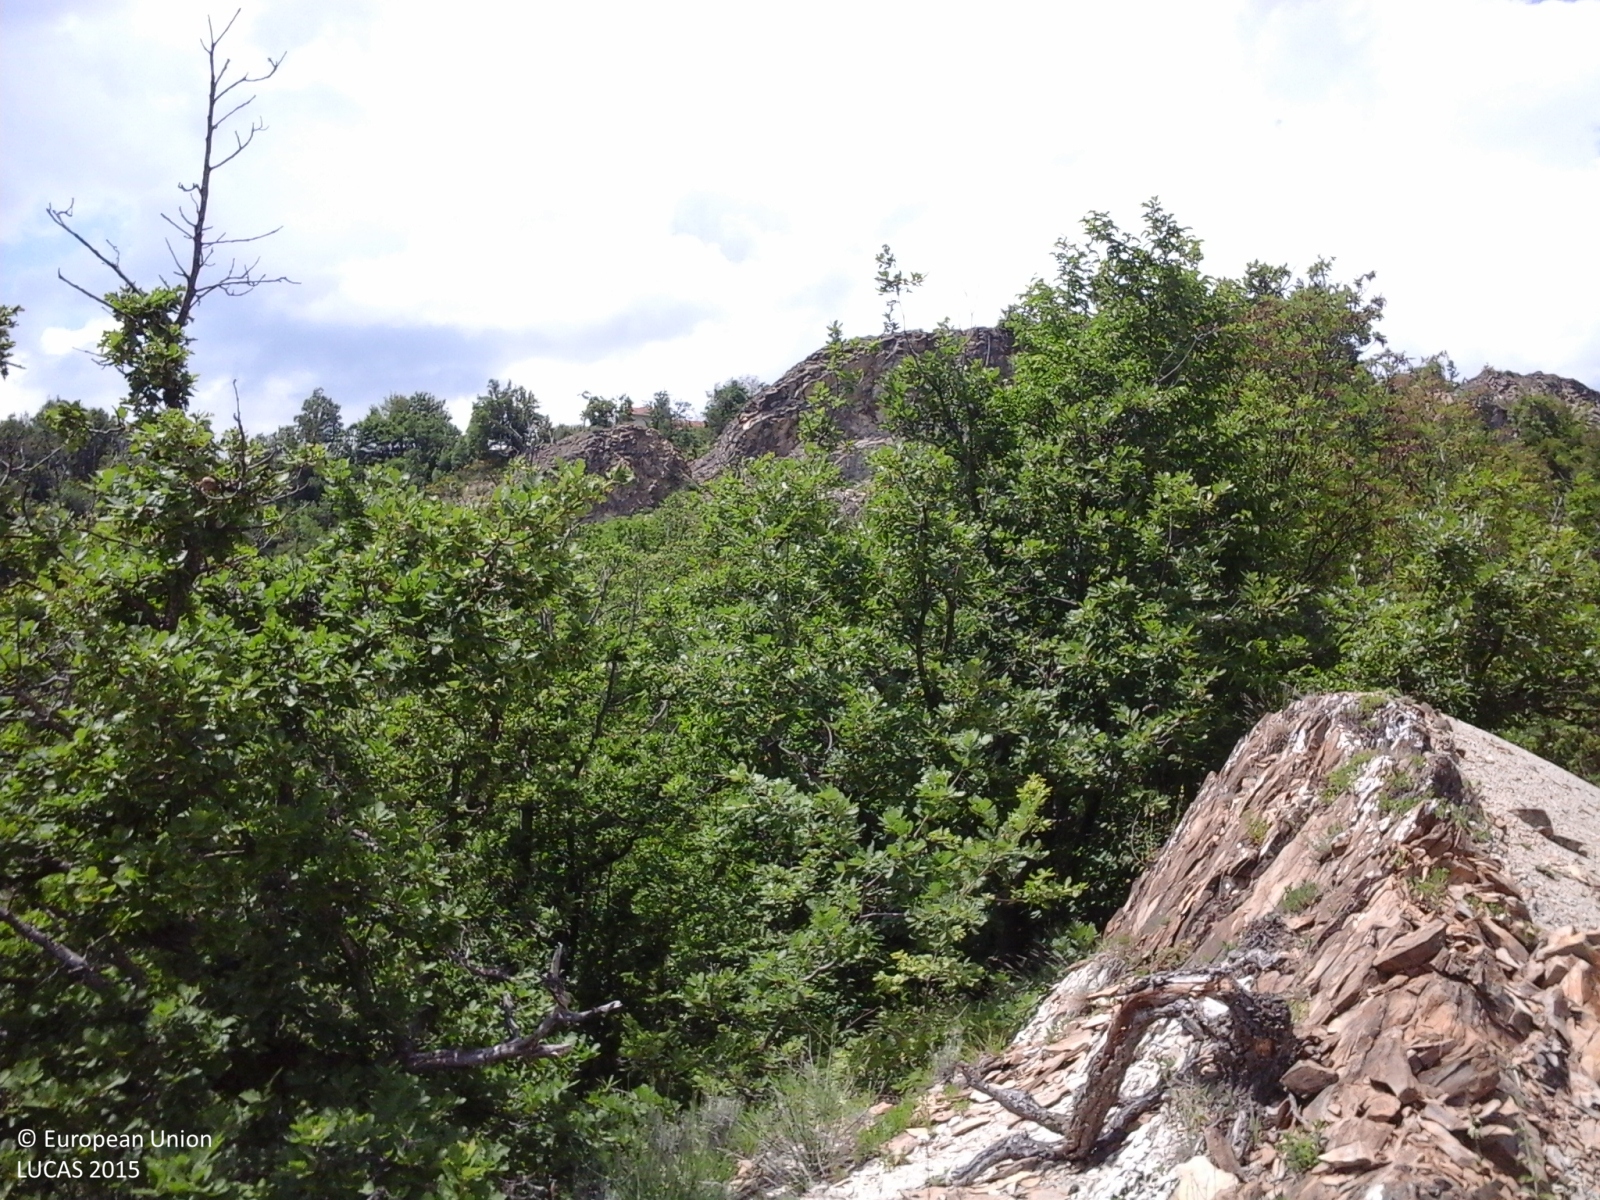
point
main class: Woodland
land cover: Broadleaved woodland
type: thermophilous deciduous forest
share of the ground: > 75 %
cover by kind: broadleaved forest trees 100 %
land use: Forestry
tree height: > 5 m
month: May
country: IT
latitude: 44.6932
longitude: 9.9119
